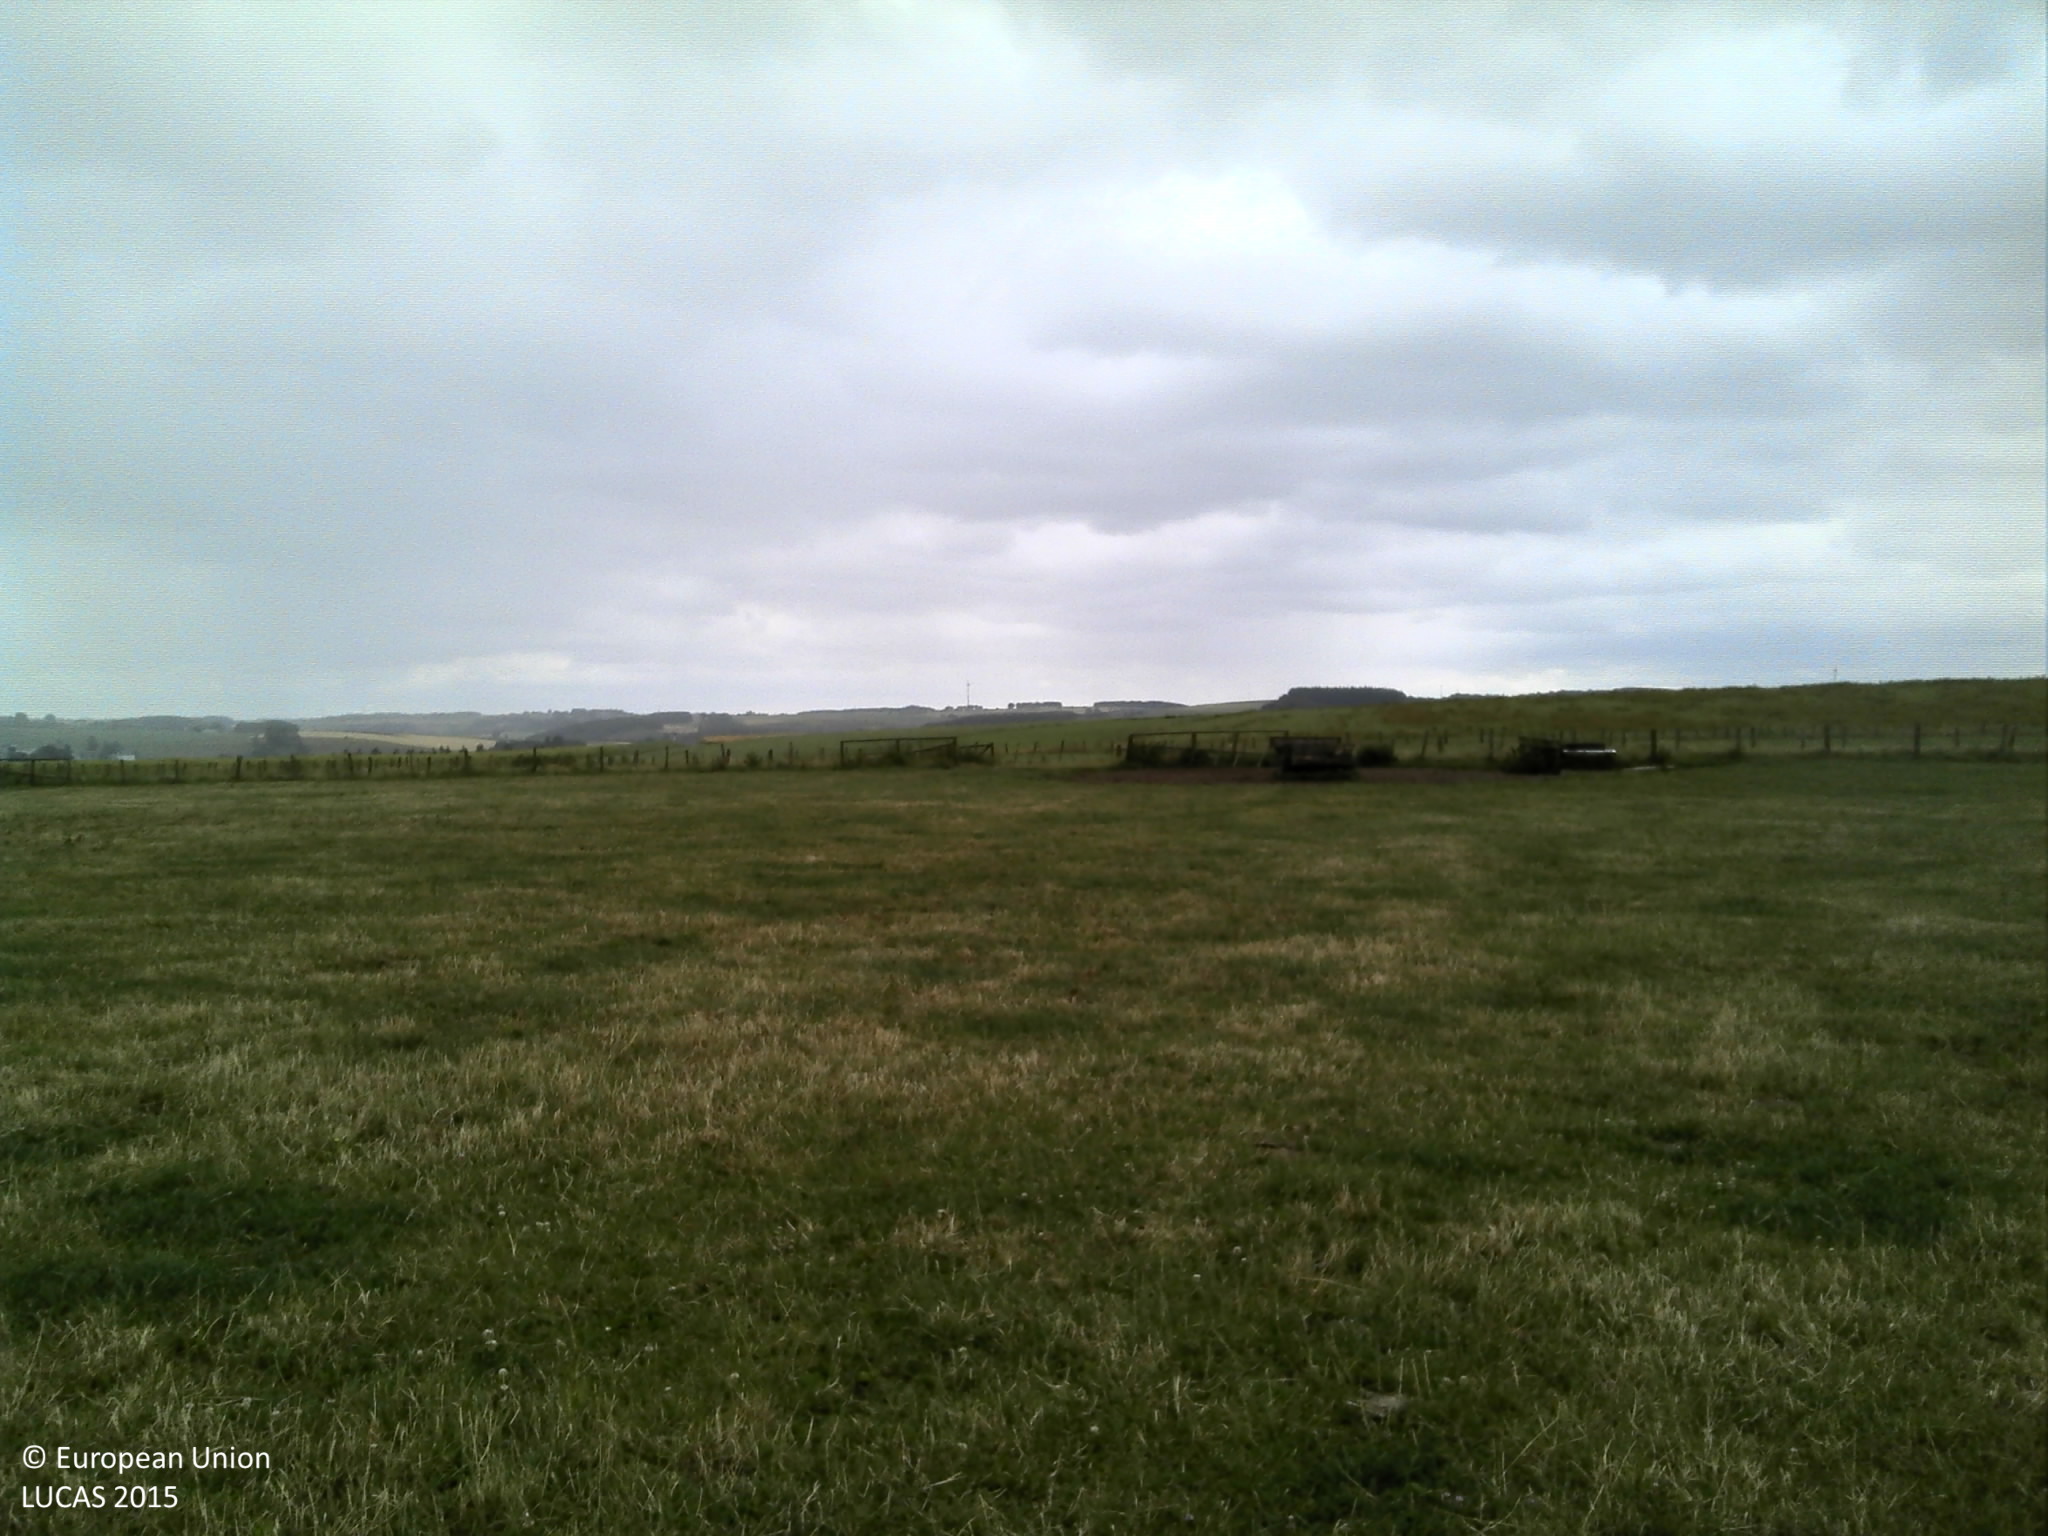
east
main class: Grassland
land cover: Grassland without tree/shrub cover
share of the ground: > 75 %
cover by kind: herbaceous plants 100 %
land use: Agriculture (excluding fallow land and kitchen gardens)
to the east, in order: Grassland without tree/shrub cover; Fences; Tracks; Fences; Grassland without tree/shrub cover; Fences; Paved roads, cycling and walking lanes; Rape and turnip rape; Barley
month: July
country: LU
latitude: 50.0937
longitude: 5.9313
